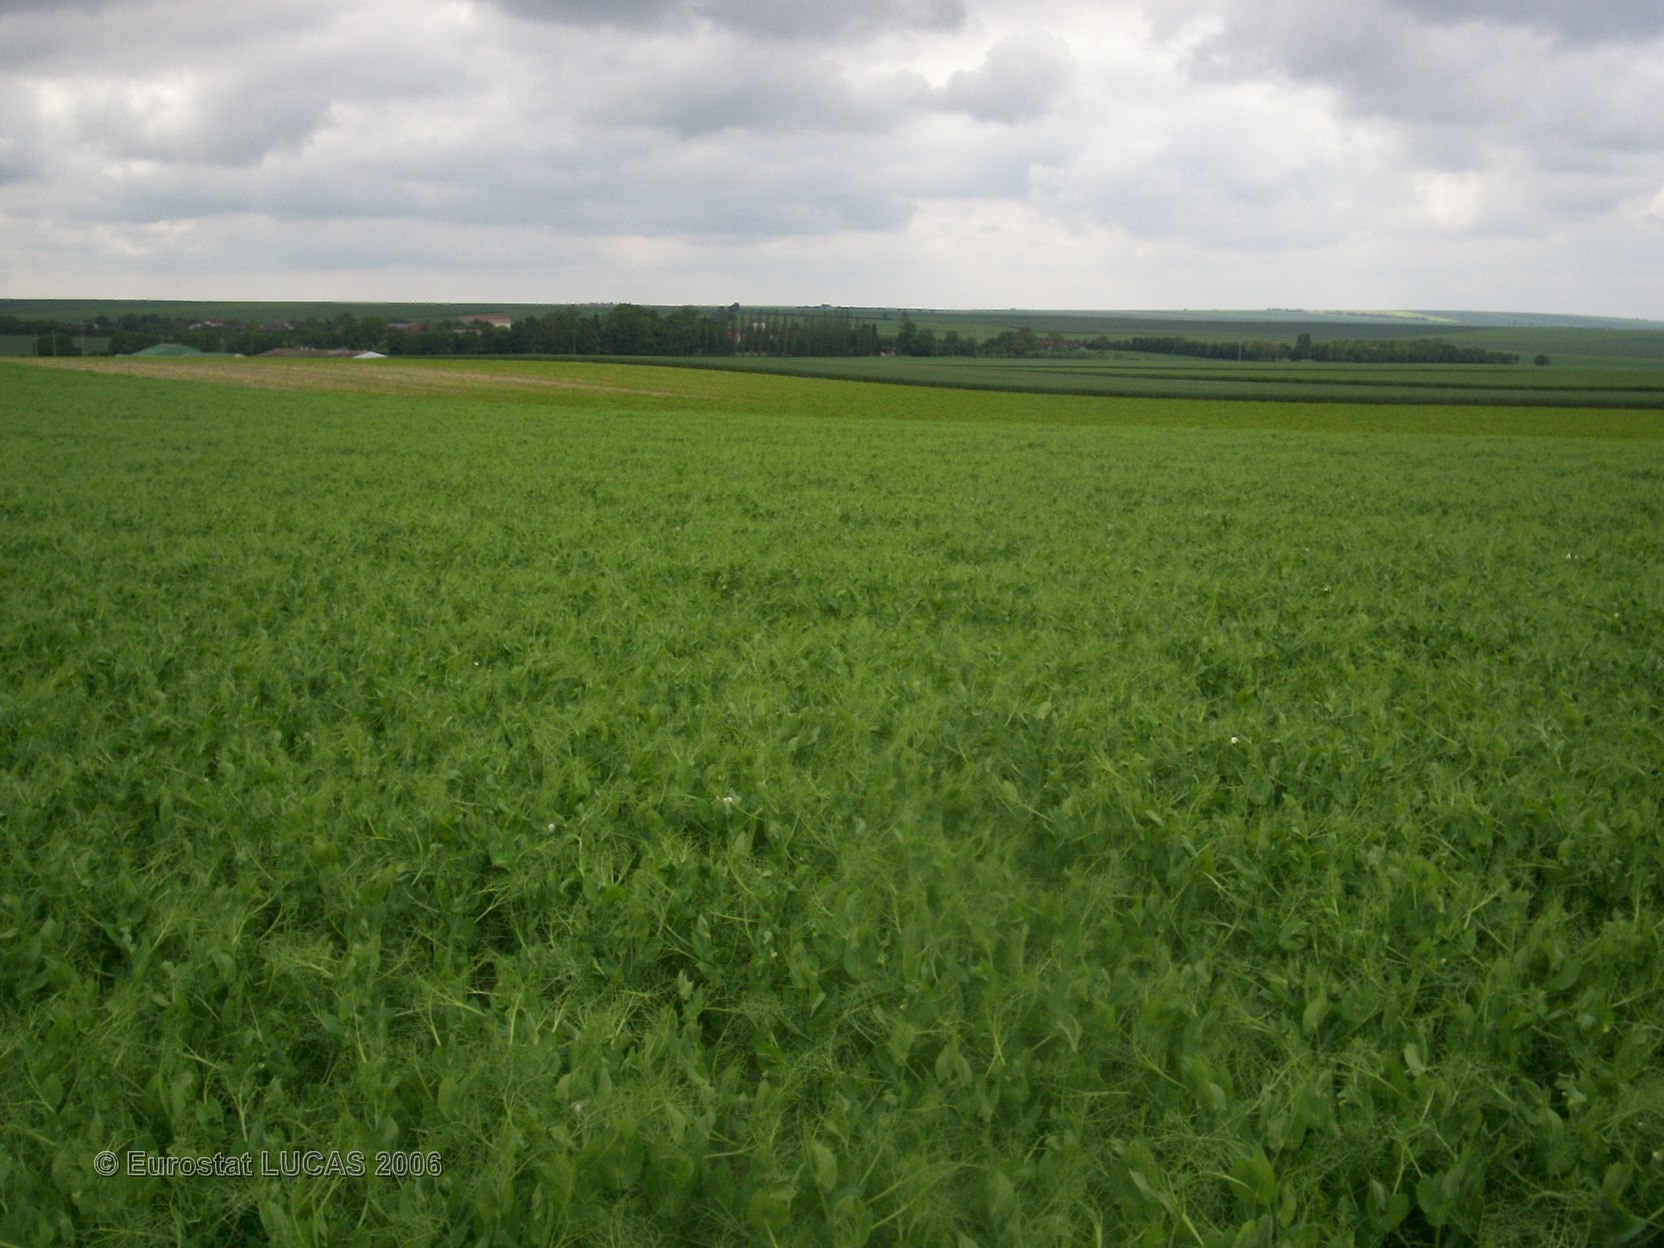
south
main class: Cropland
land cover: Common wheat
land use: Agriculture (excluding fallow land and kitchen gardens)
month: June
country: FR
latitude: 48.5875
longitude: 4.4250
